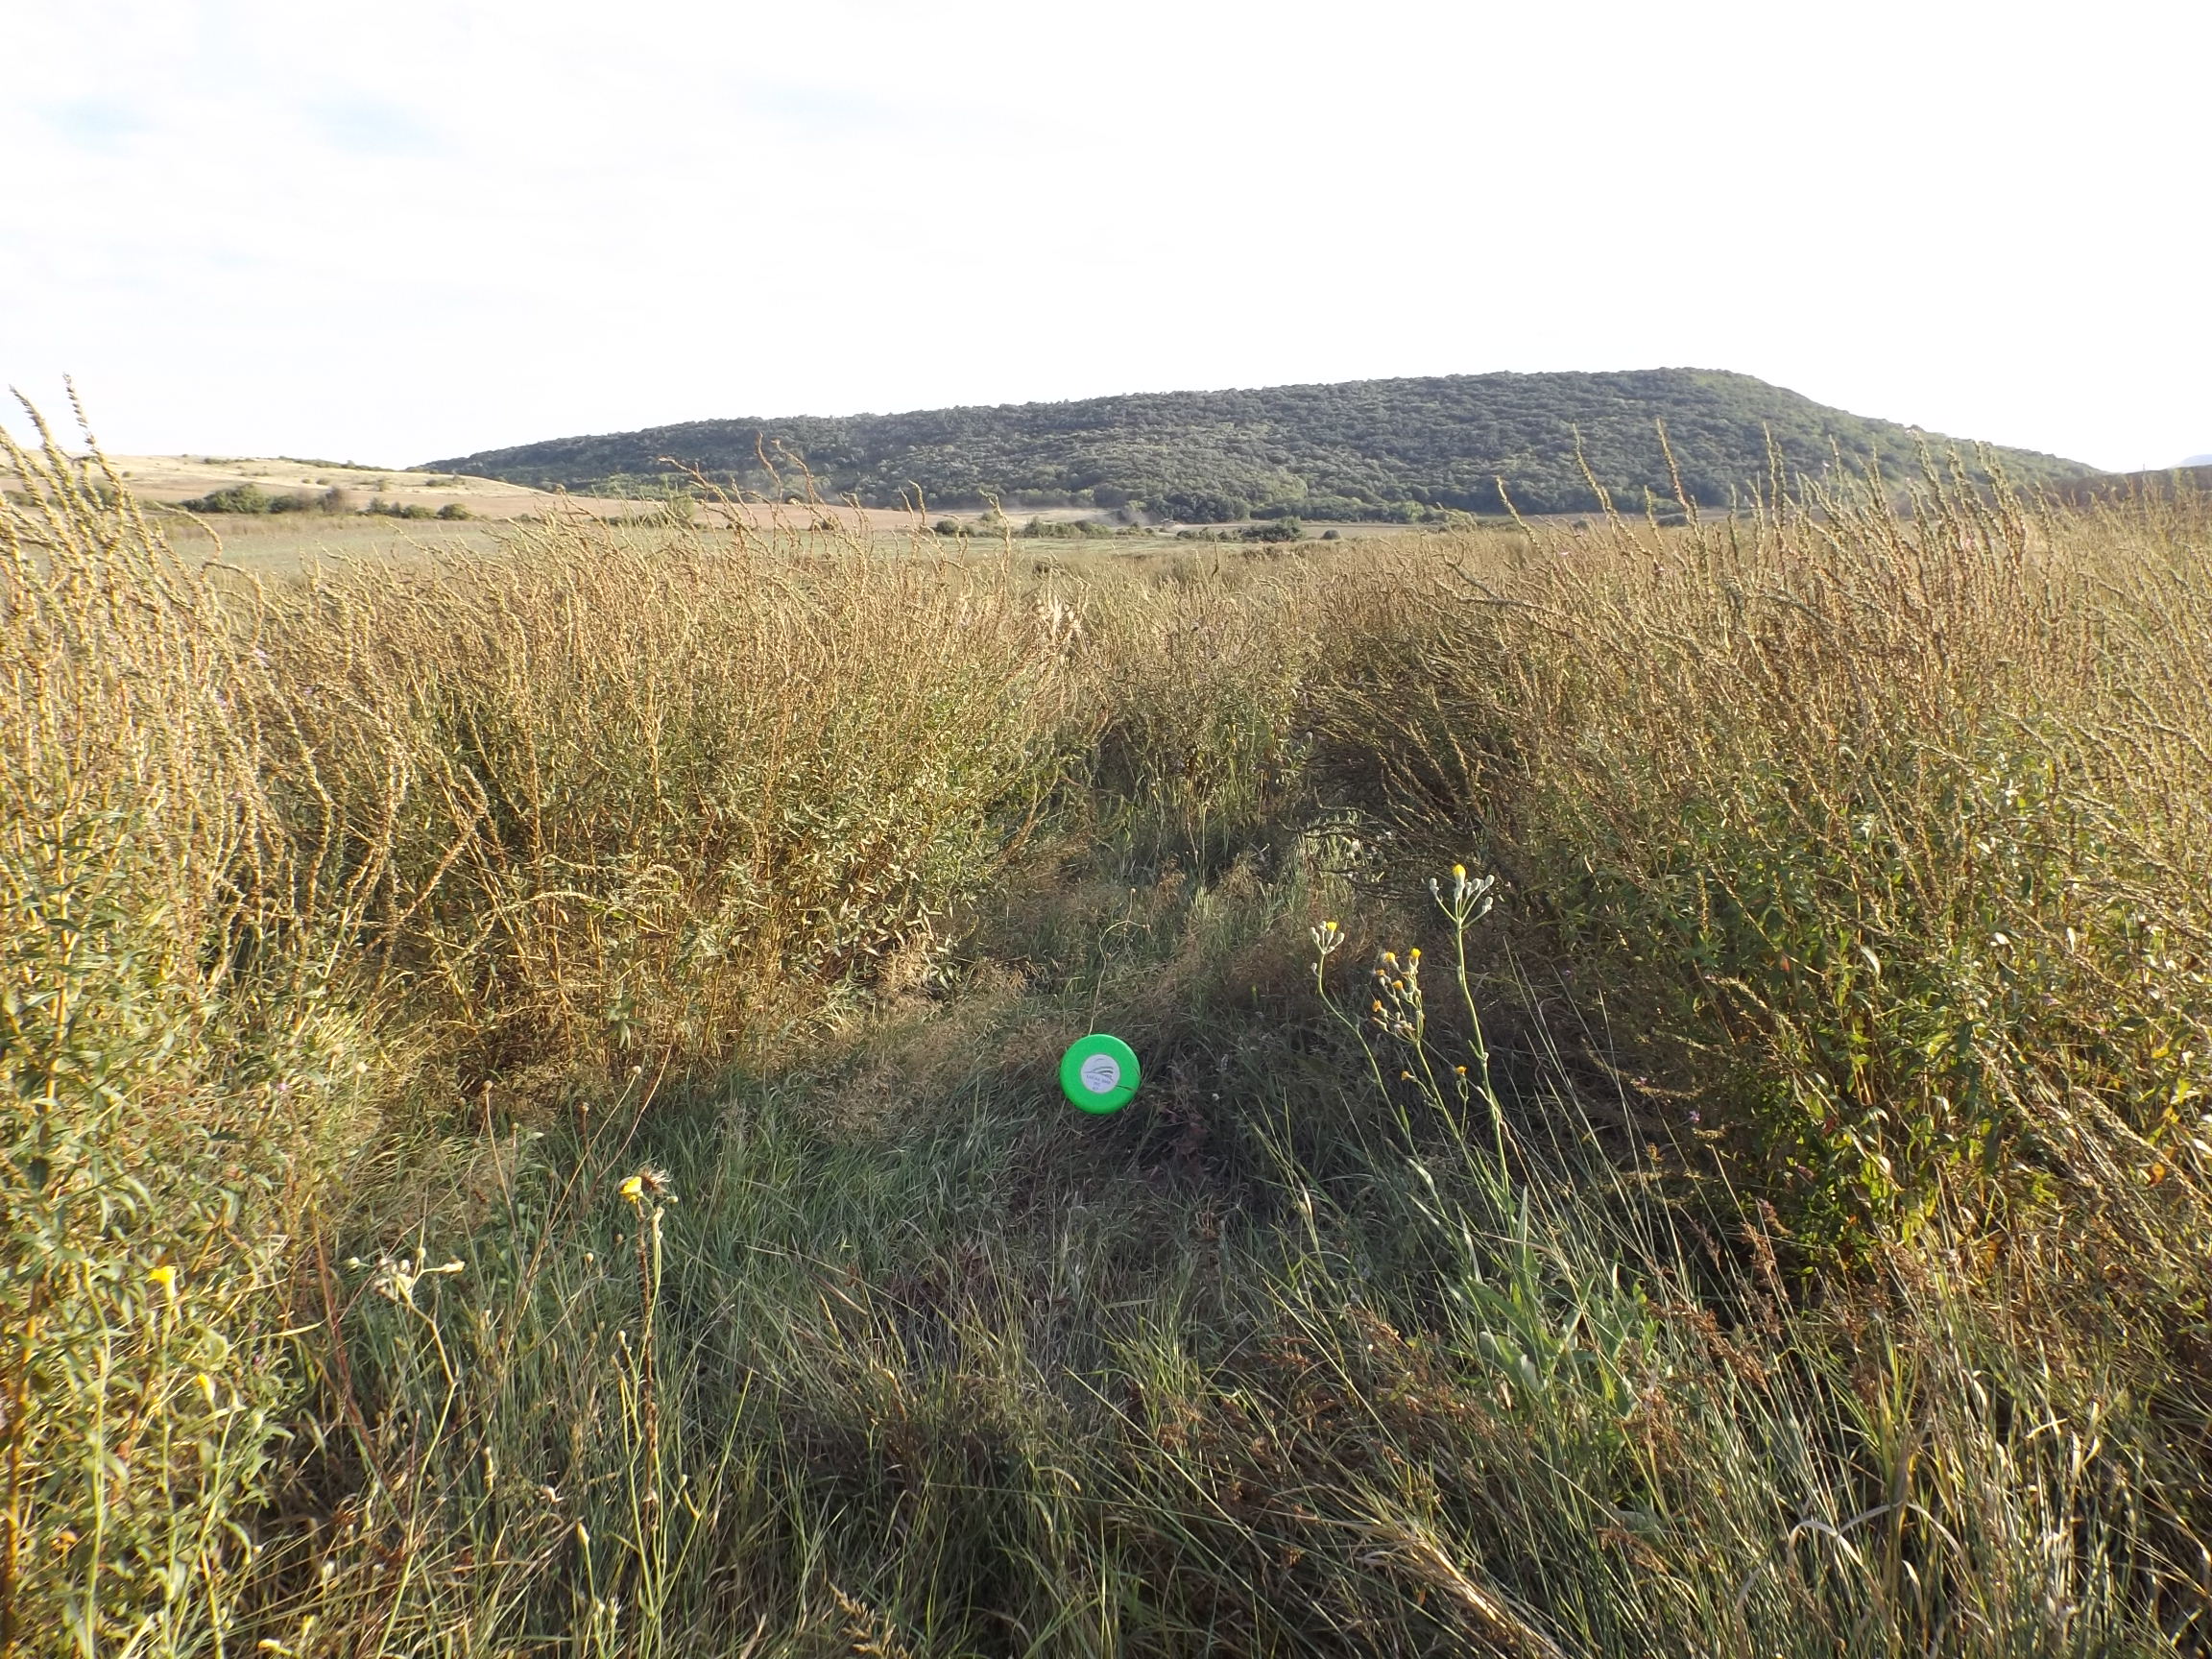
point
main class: Grassland
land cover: Spontaneously vegetated surfaces
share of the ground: > 75 %
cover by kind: herbaceous plants 95 %, shrubs 5 %
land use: Semi-natural and natural areas not in use
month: September
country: BG
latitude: 43.3657
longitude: 27.3902
